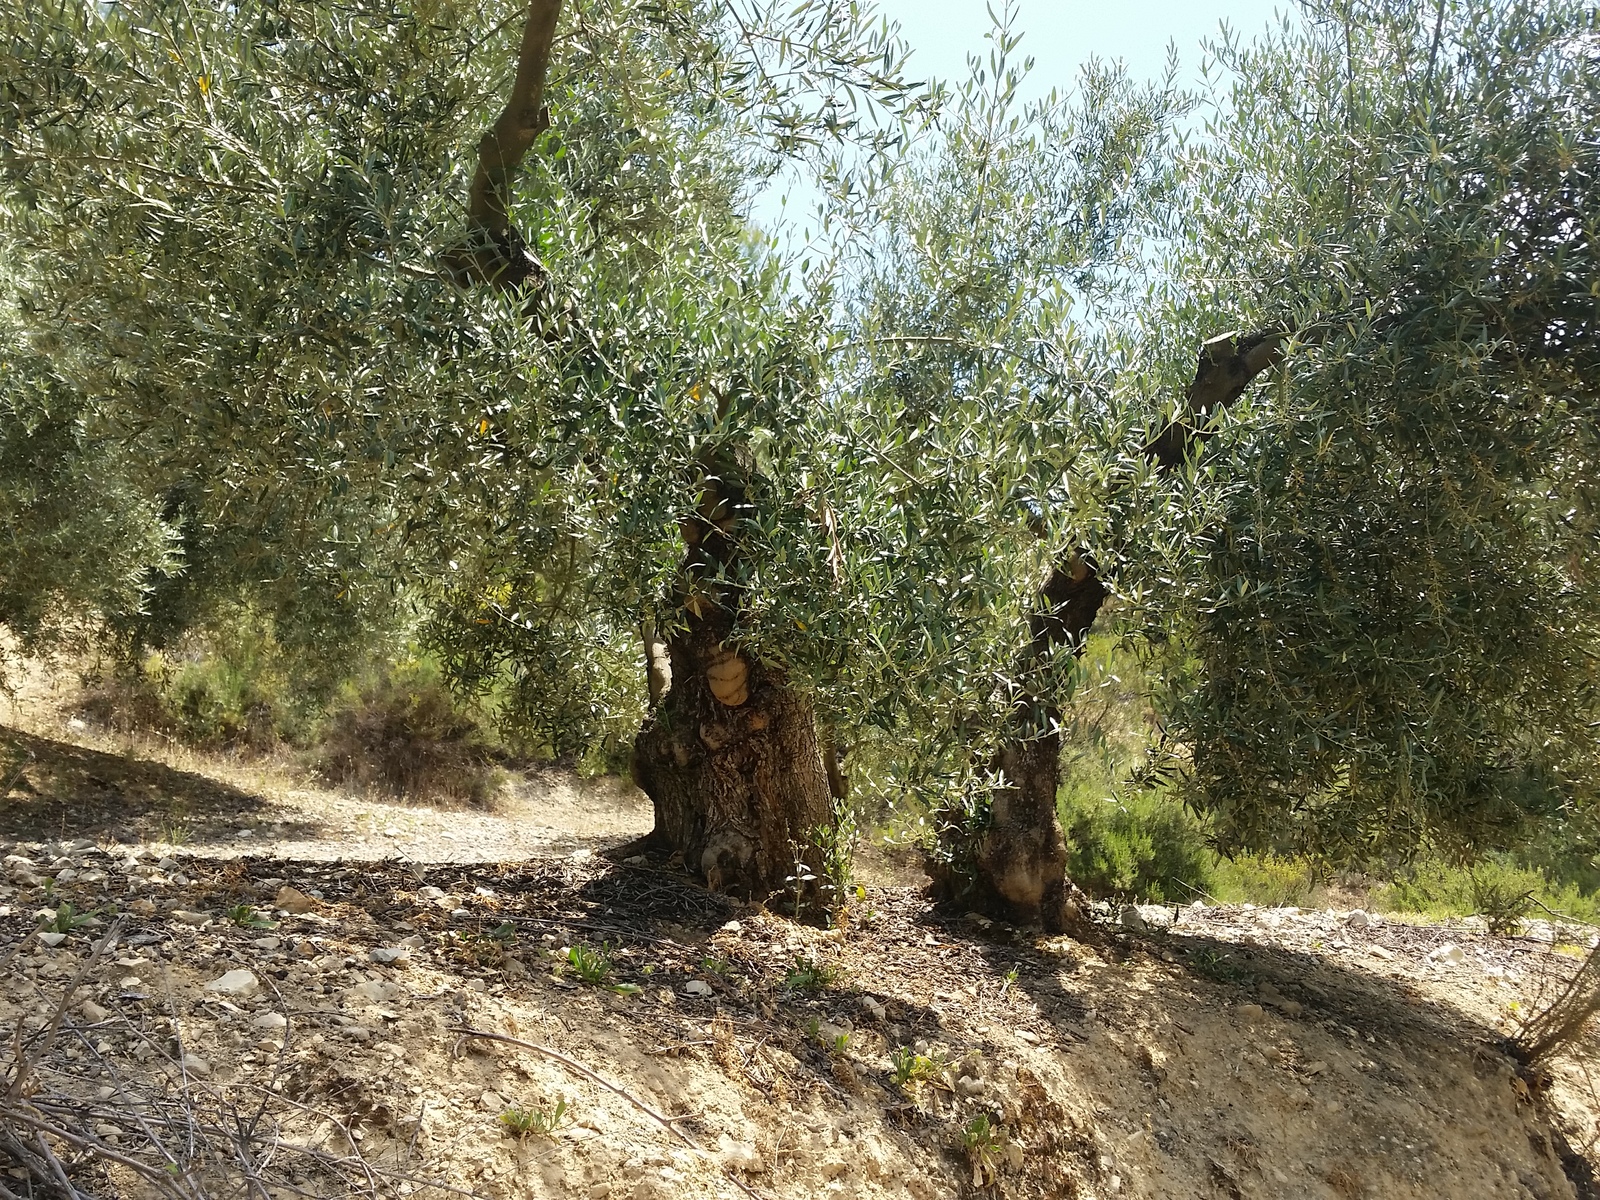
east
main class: Cropland
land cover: Olive groves
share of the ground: 50 - 75 %
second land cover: Other bare soil
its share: > 75 %
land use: Agriculture (excluding fallow land and kitchen gardens)
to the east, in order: Tracks; Olive groves; Other bare soil; Pine dominated coniferous woodland; Olive groves; Pine dominated coniferous woodland; Olive groves; Tracks; Olive groves; Tracks; Olive groves
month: June
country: ES
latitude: 38.3747
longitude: -2.5777
